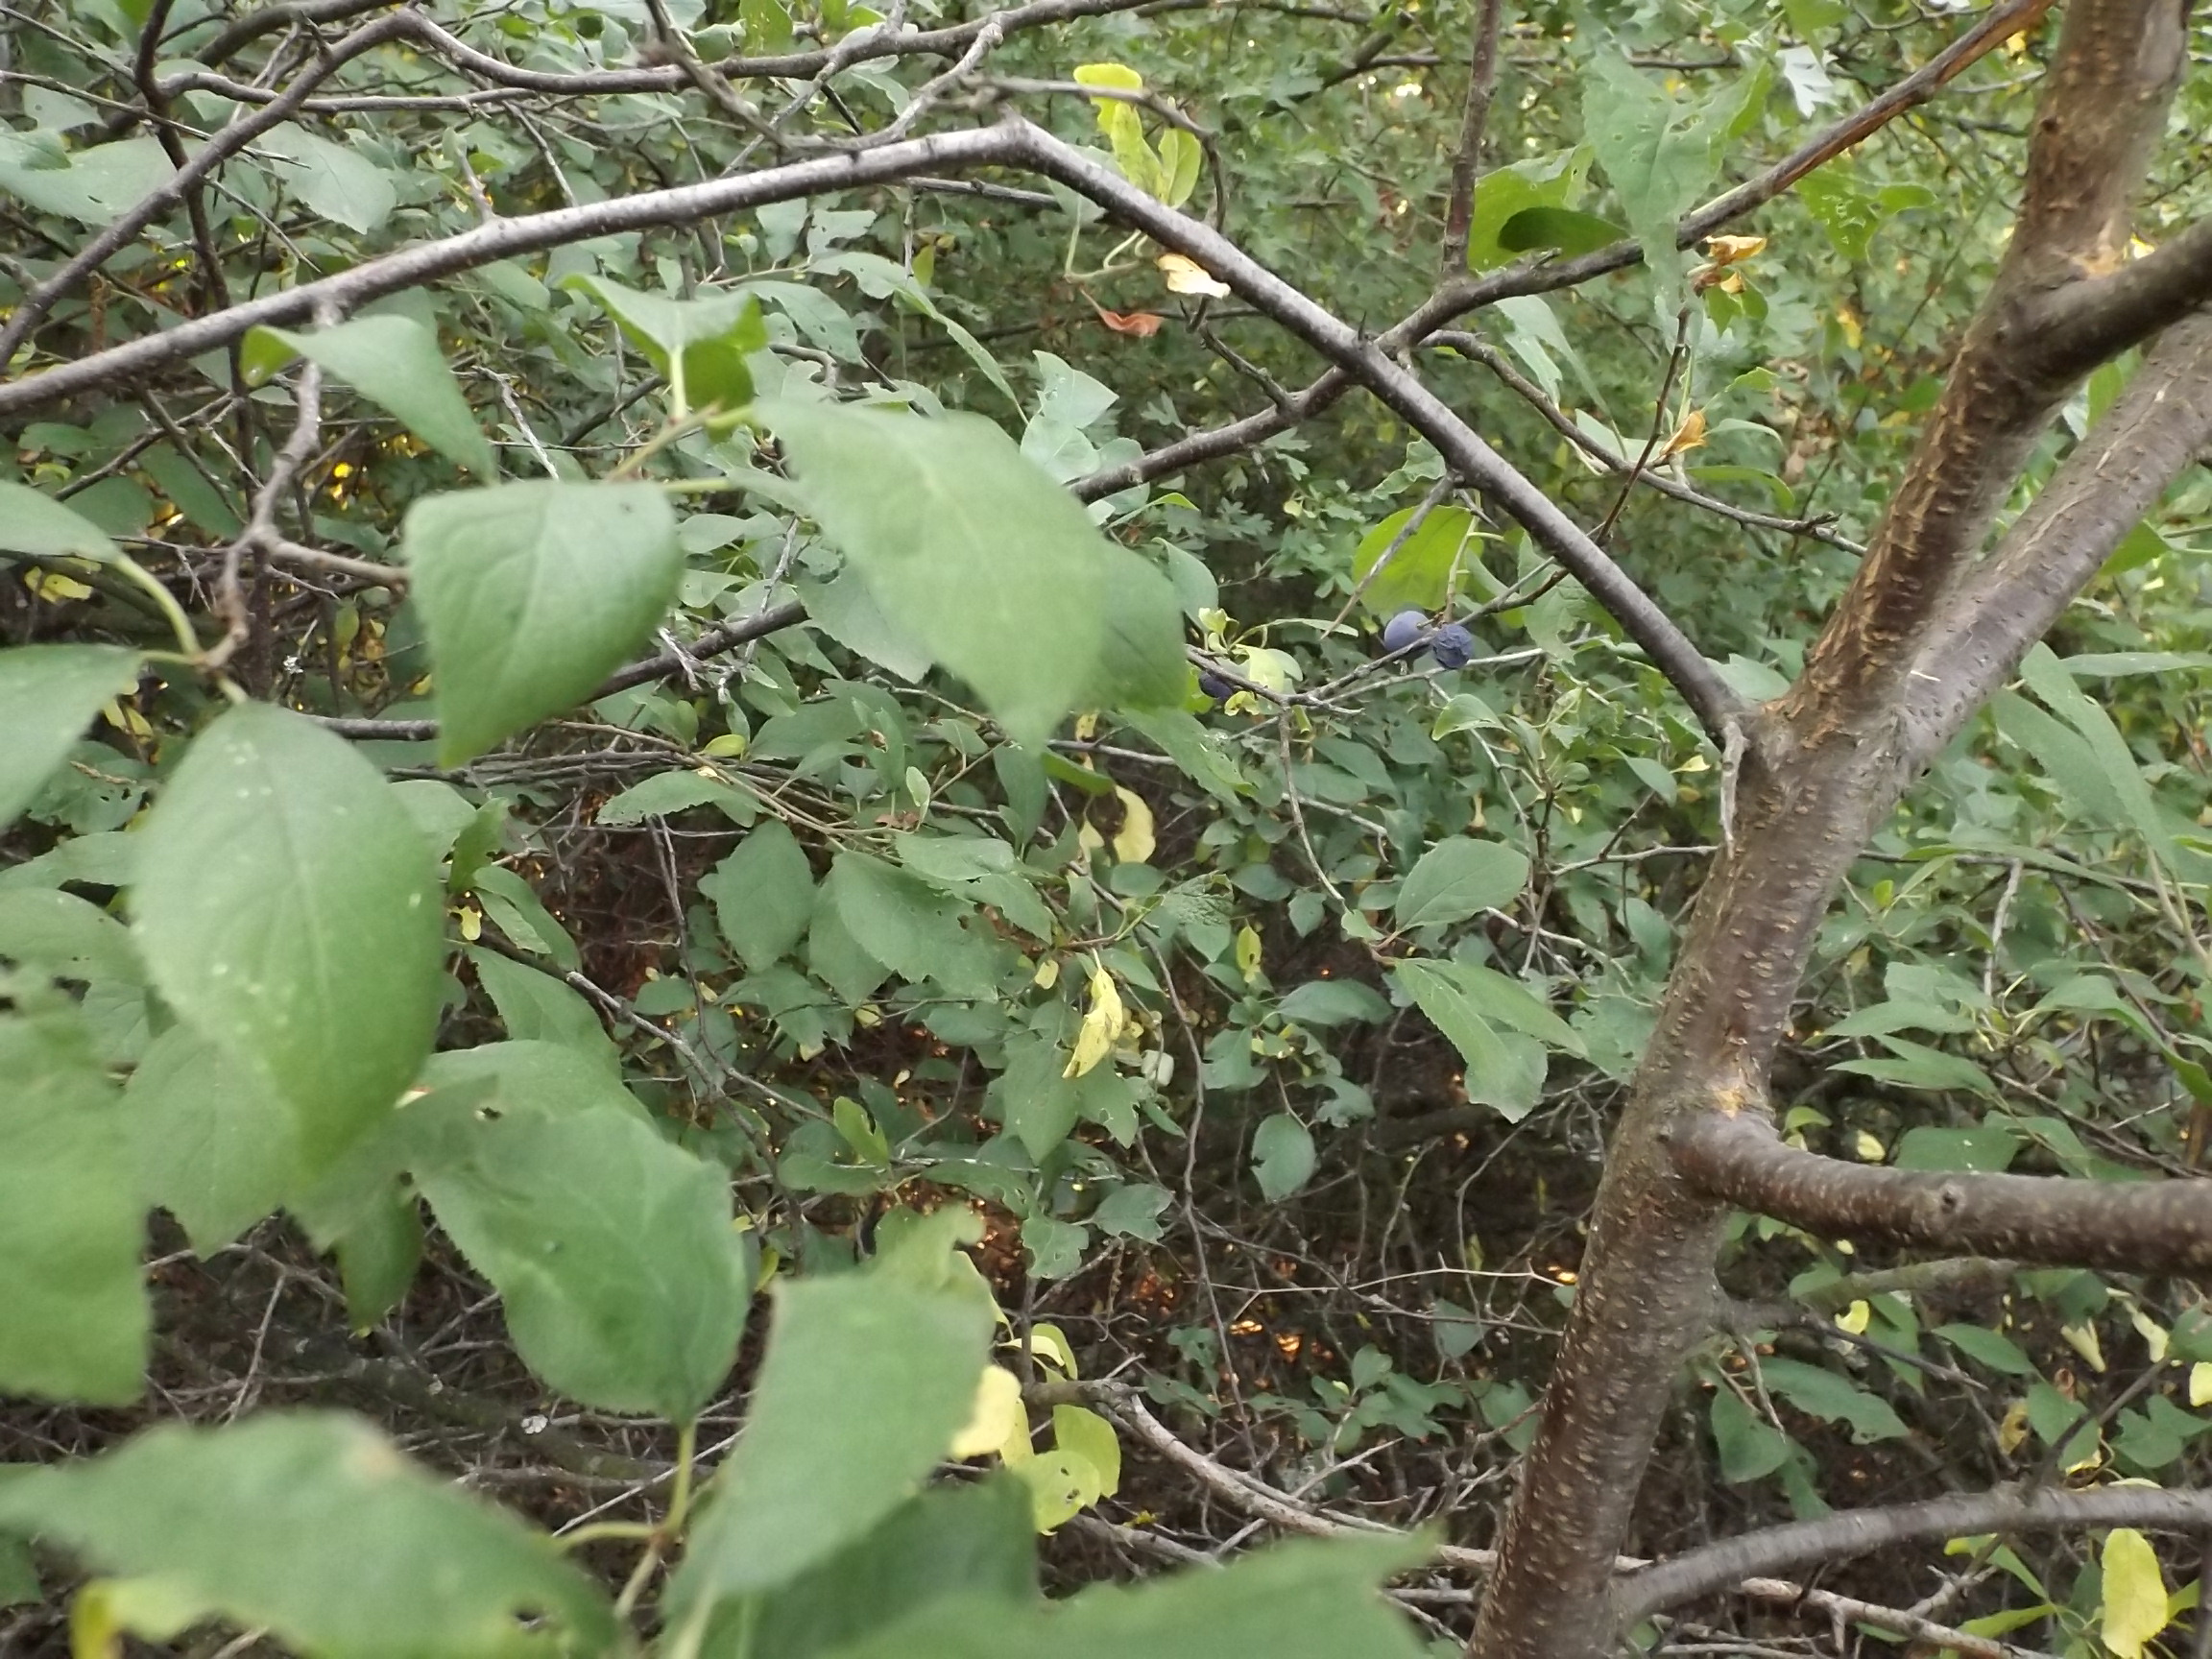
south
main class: Woodland
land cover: Broadleaved woodland
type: beech forest
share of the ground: 50 - 75 %
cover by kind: broadleaved forest trees 70 %, shrubs 20 %, herbaceous plants 10 %
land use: Forestry
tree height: > 5 m
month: July
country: BG
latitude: 43.4721
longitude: 27.6262
